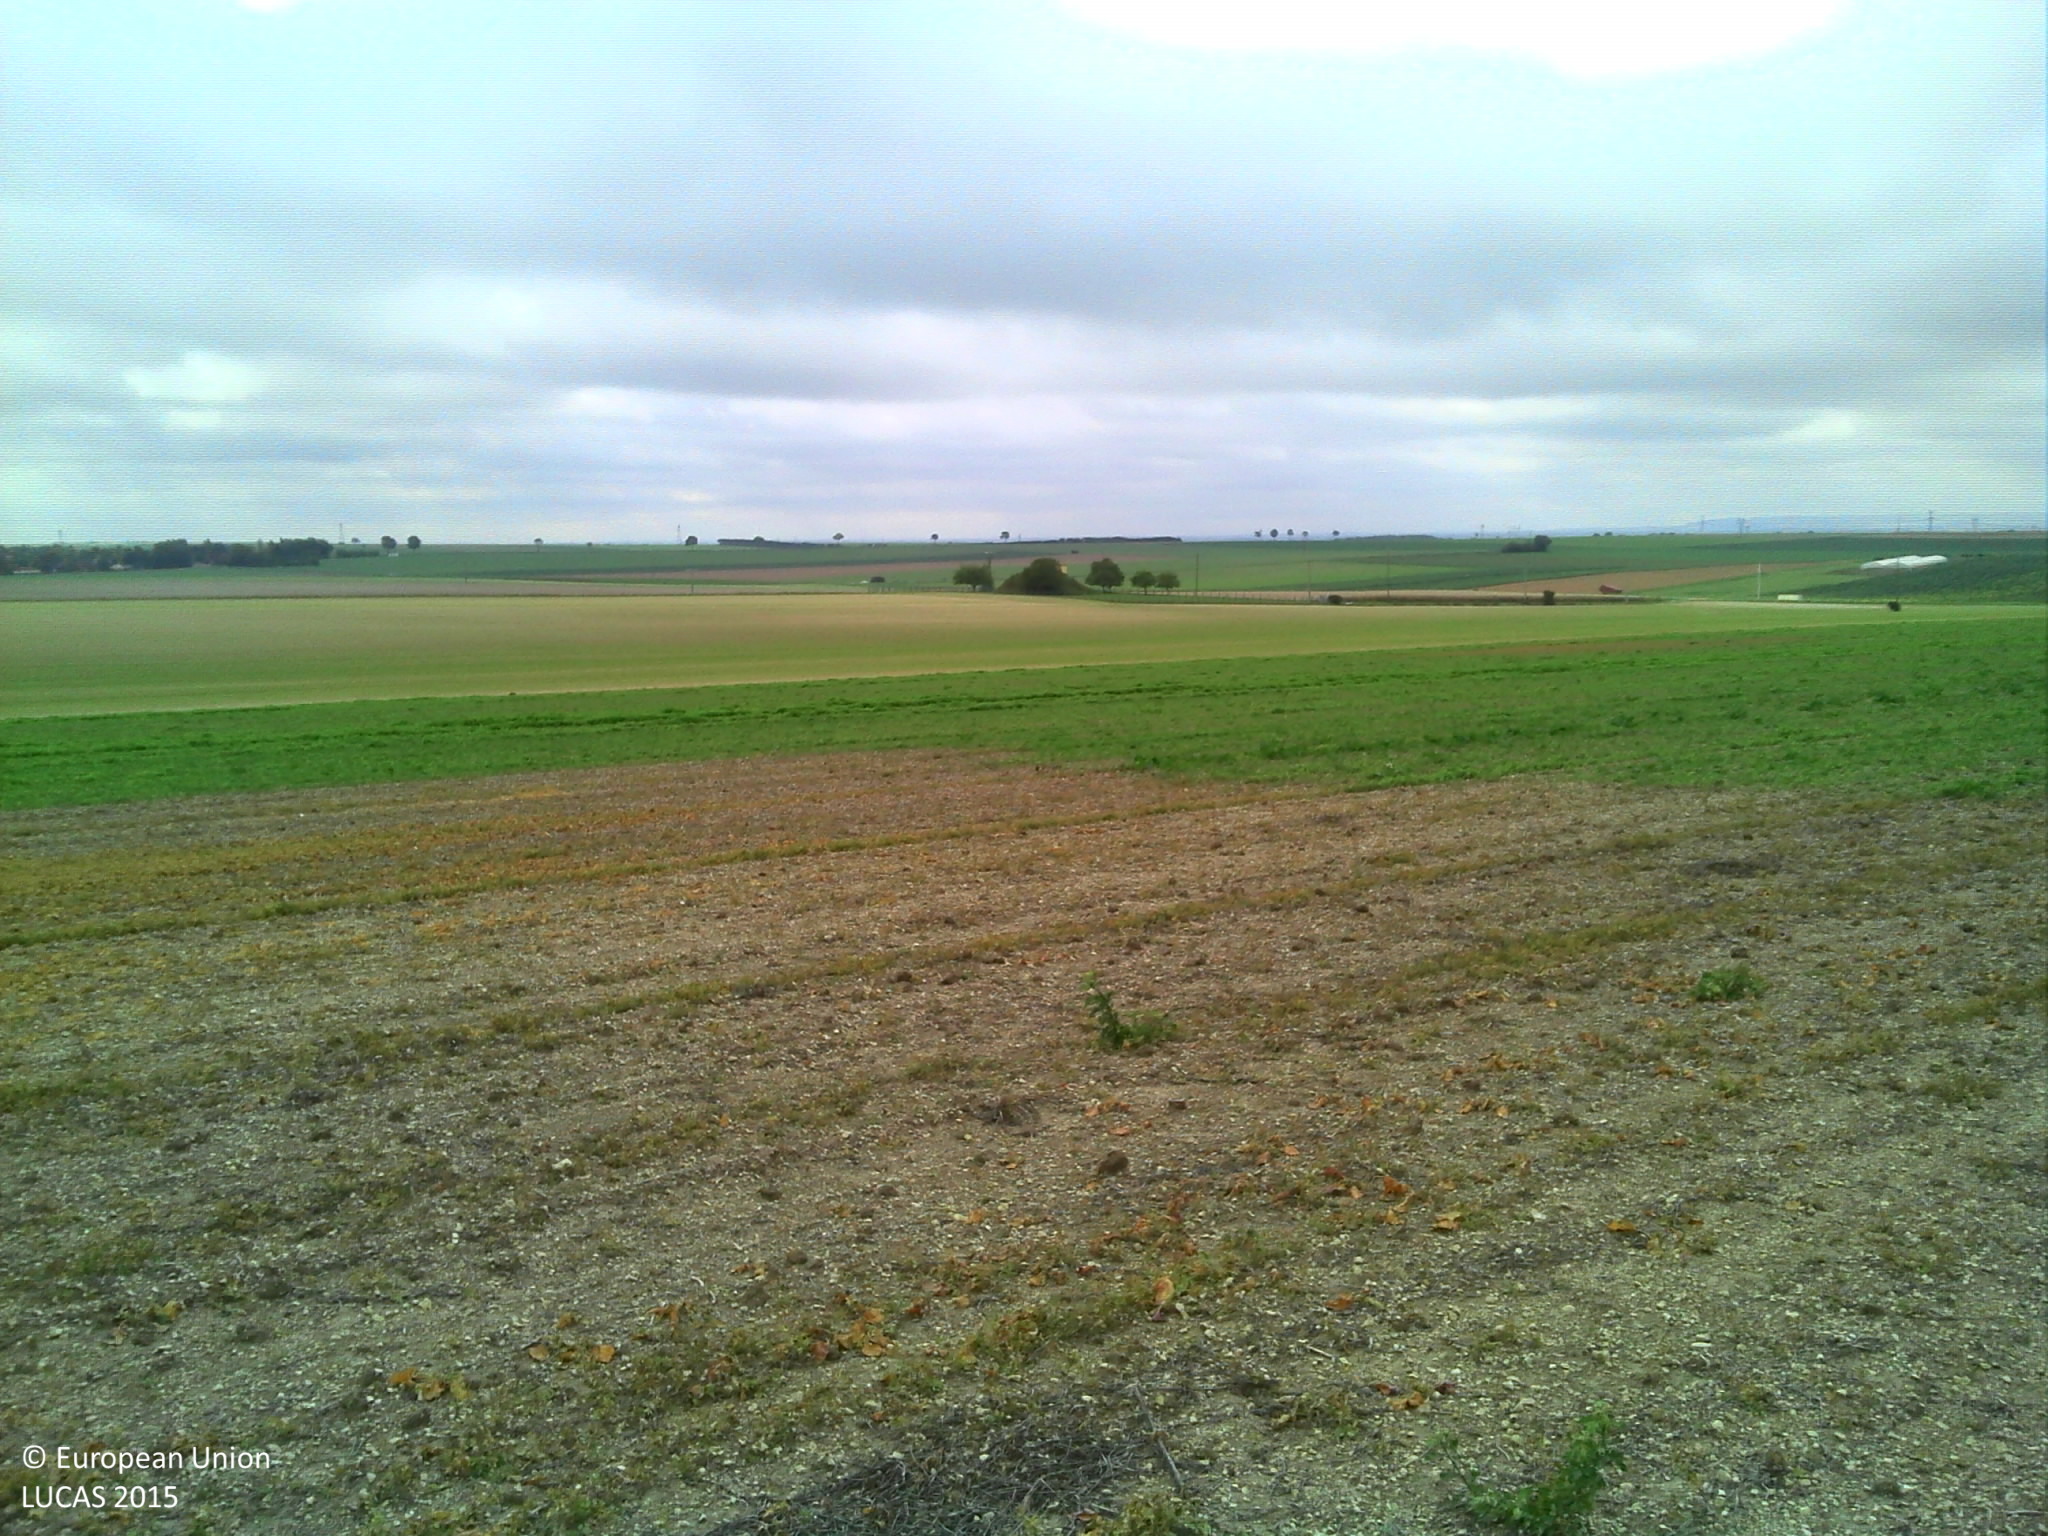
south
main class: Cropland
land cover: Soya
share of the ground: 10 - 25 %
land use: Agriculture (excluding fallow land and kitchen gardens)
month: September
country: FR
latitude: 48.3599
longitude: 4.2066
